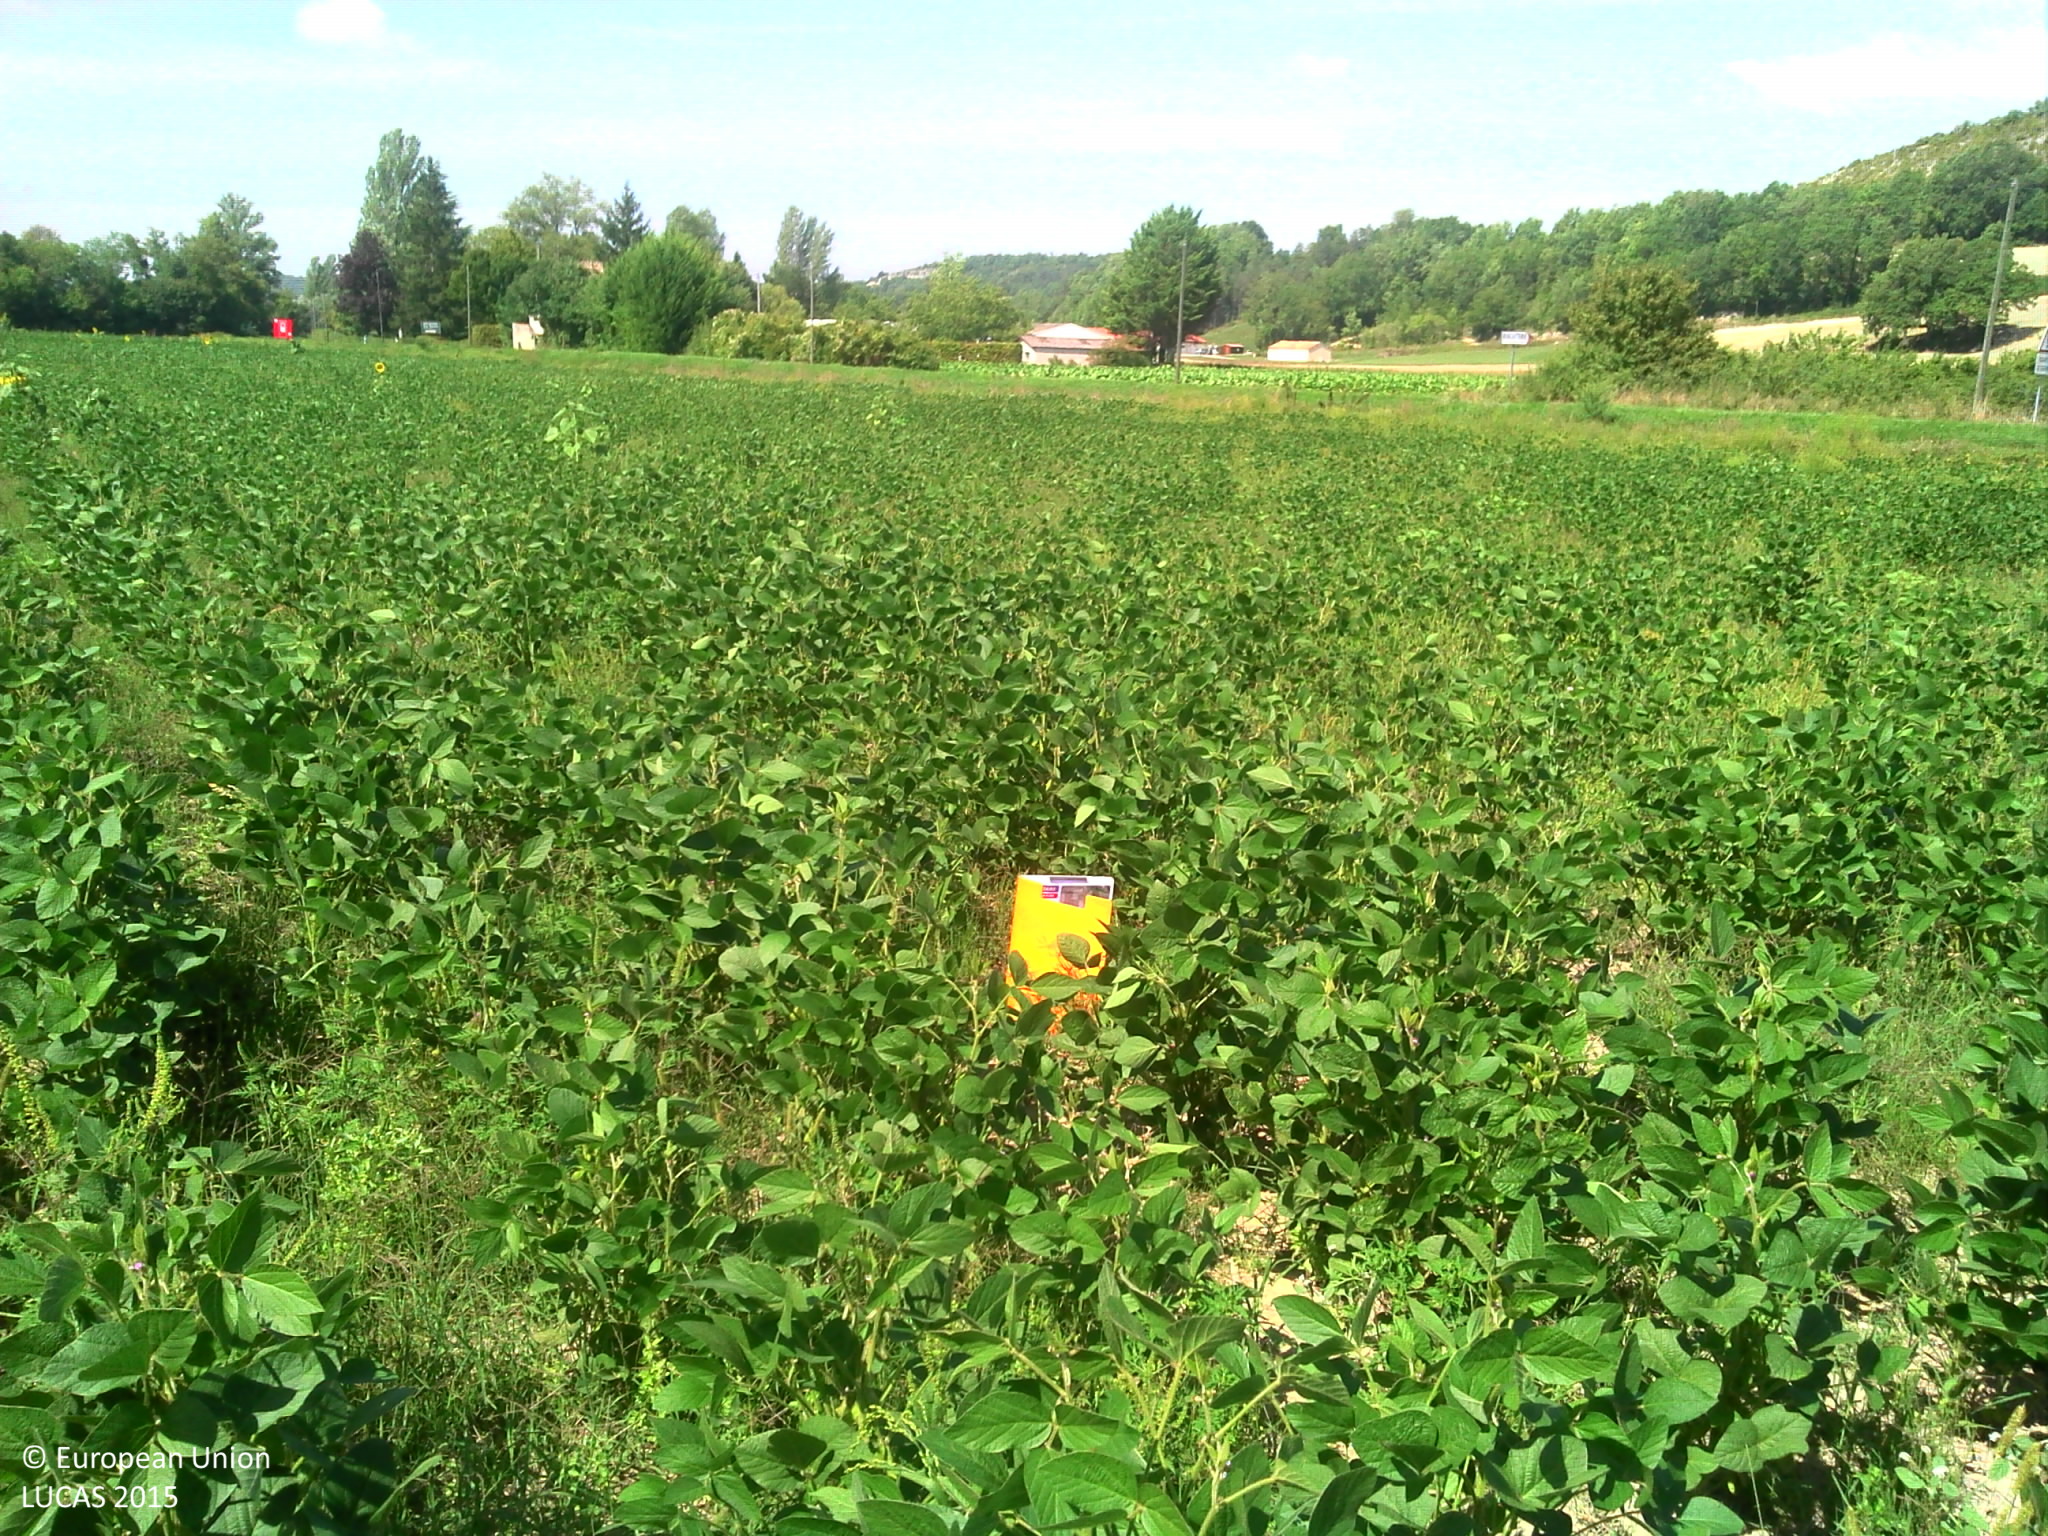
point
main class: Cropland
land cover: Soya
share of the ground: > 75 %
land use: Agriculture (excluding fallow land and kitchen gardens)
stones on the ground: < 10 %
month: August
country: FR
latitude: 44.3613
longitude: 1.2521
